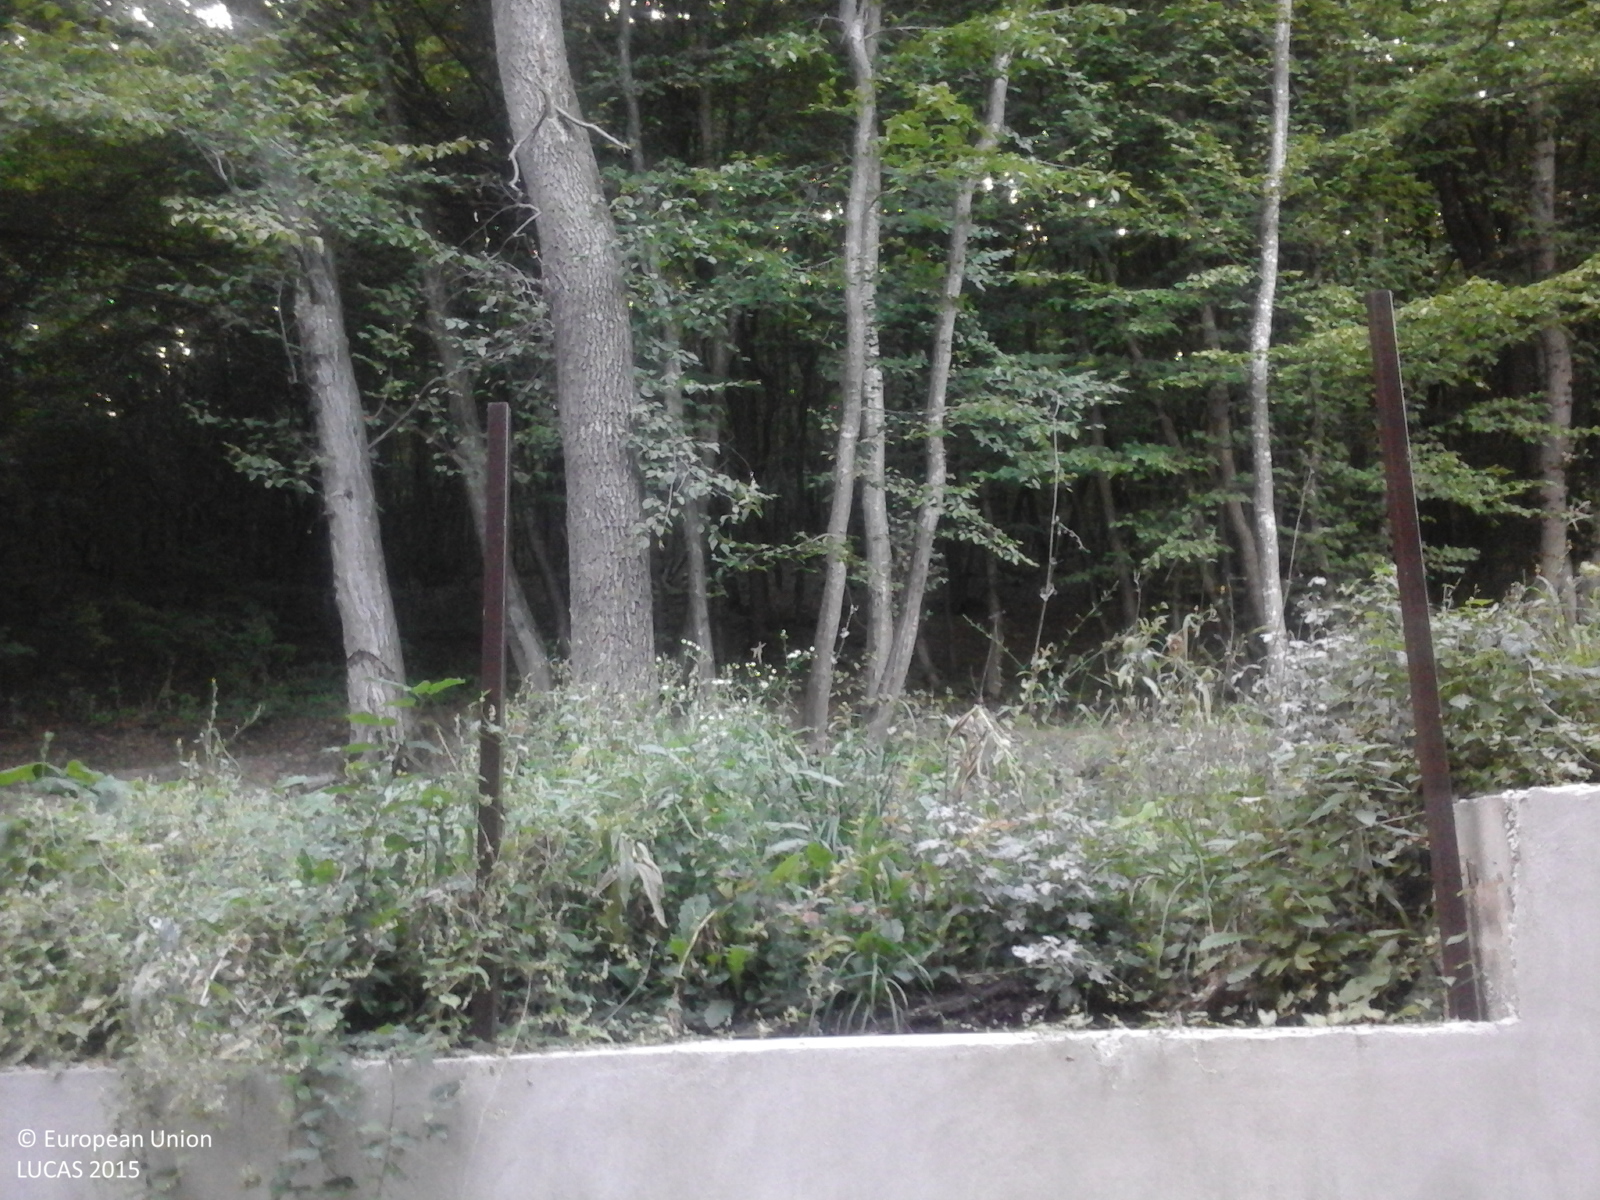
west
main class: Grassland
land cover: Grassland without tree/shrub cover
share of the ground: > 75 %
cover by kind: herbaceous plants 100 %
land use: Agriculture (excluding fallow land and kitchen gardens)
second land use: Residential
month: September
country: RO
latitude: 46.7417
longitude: 23.5644
